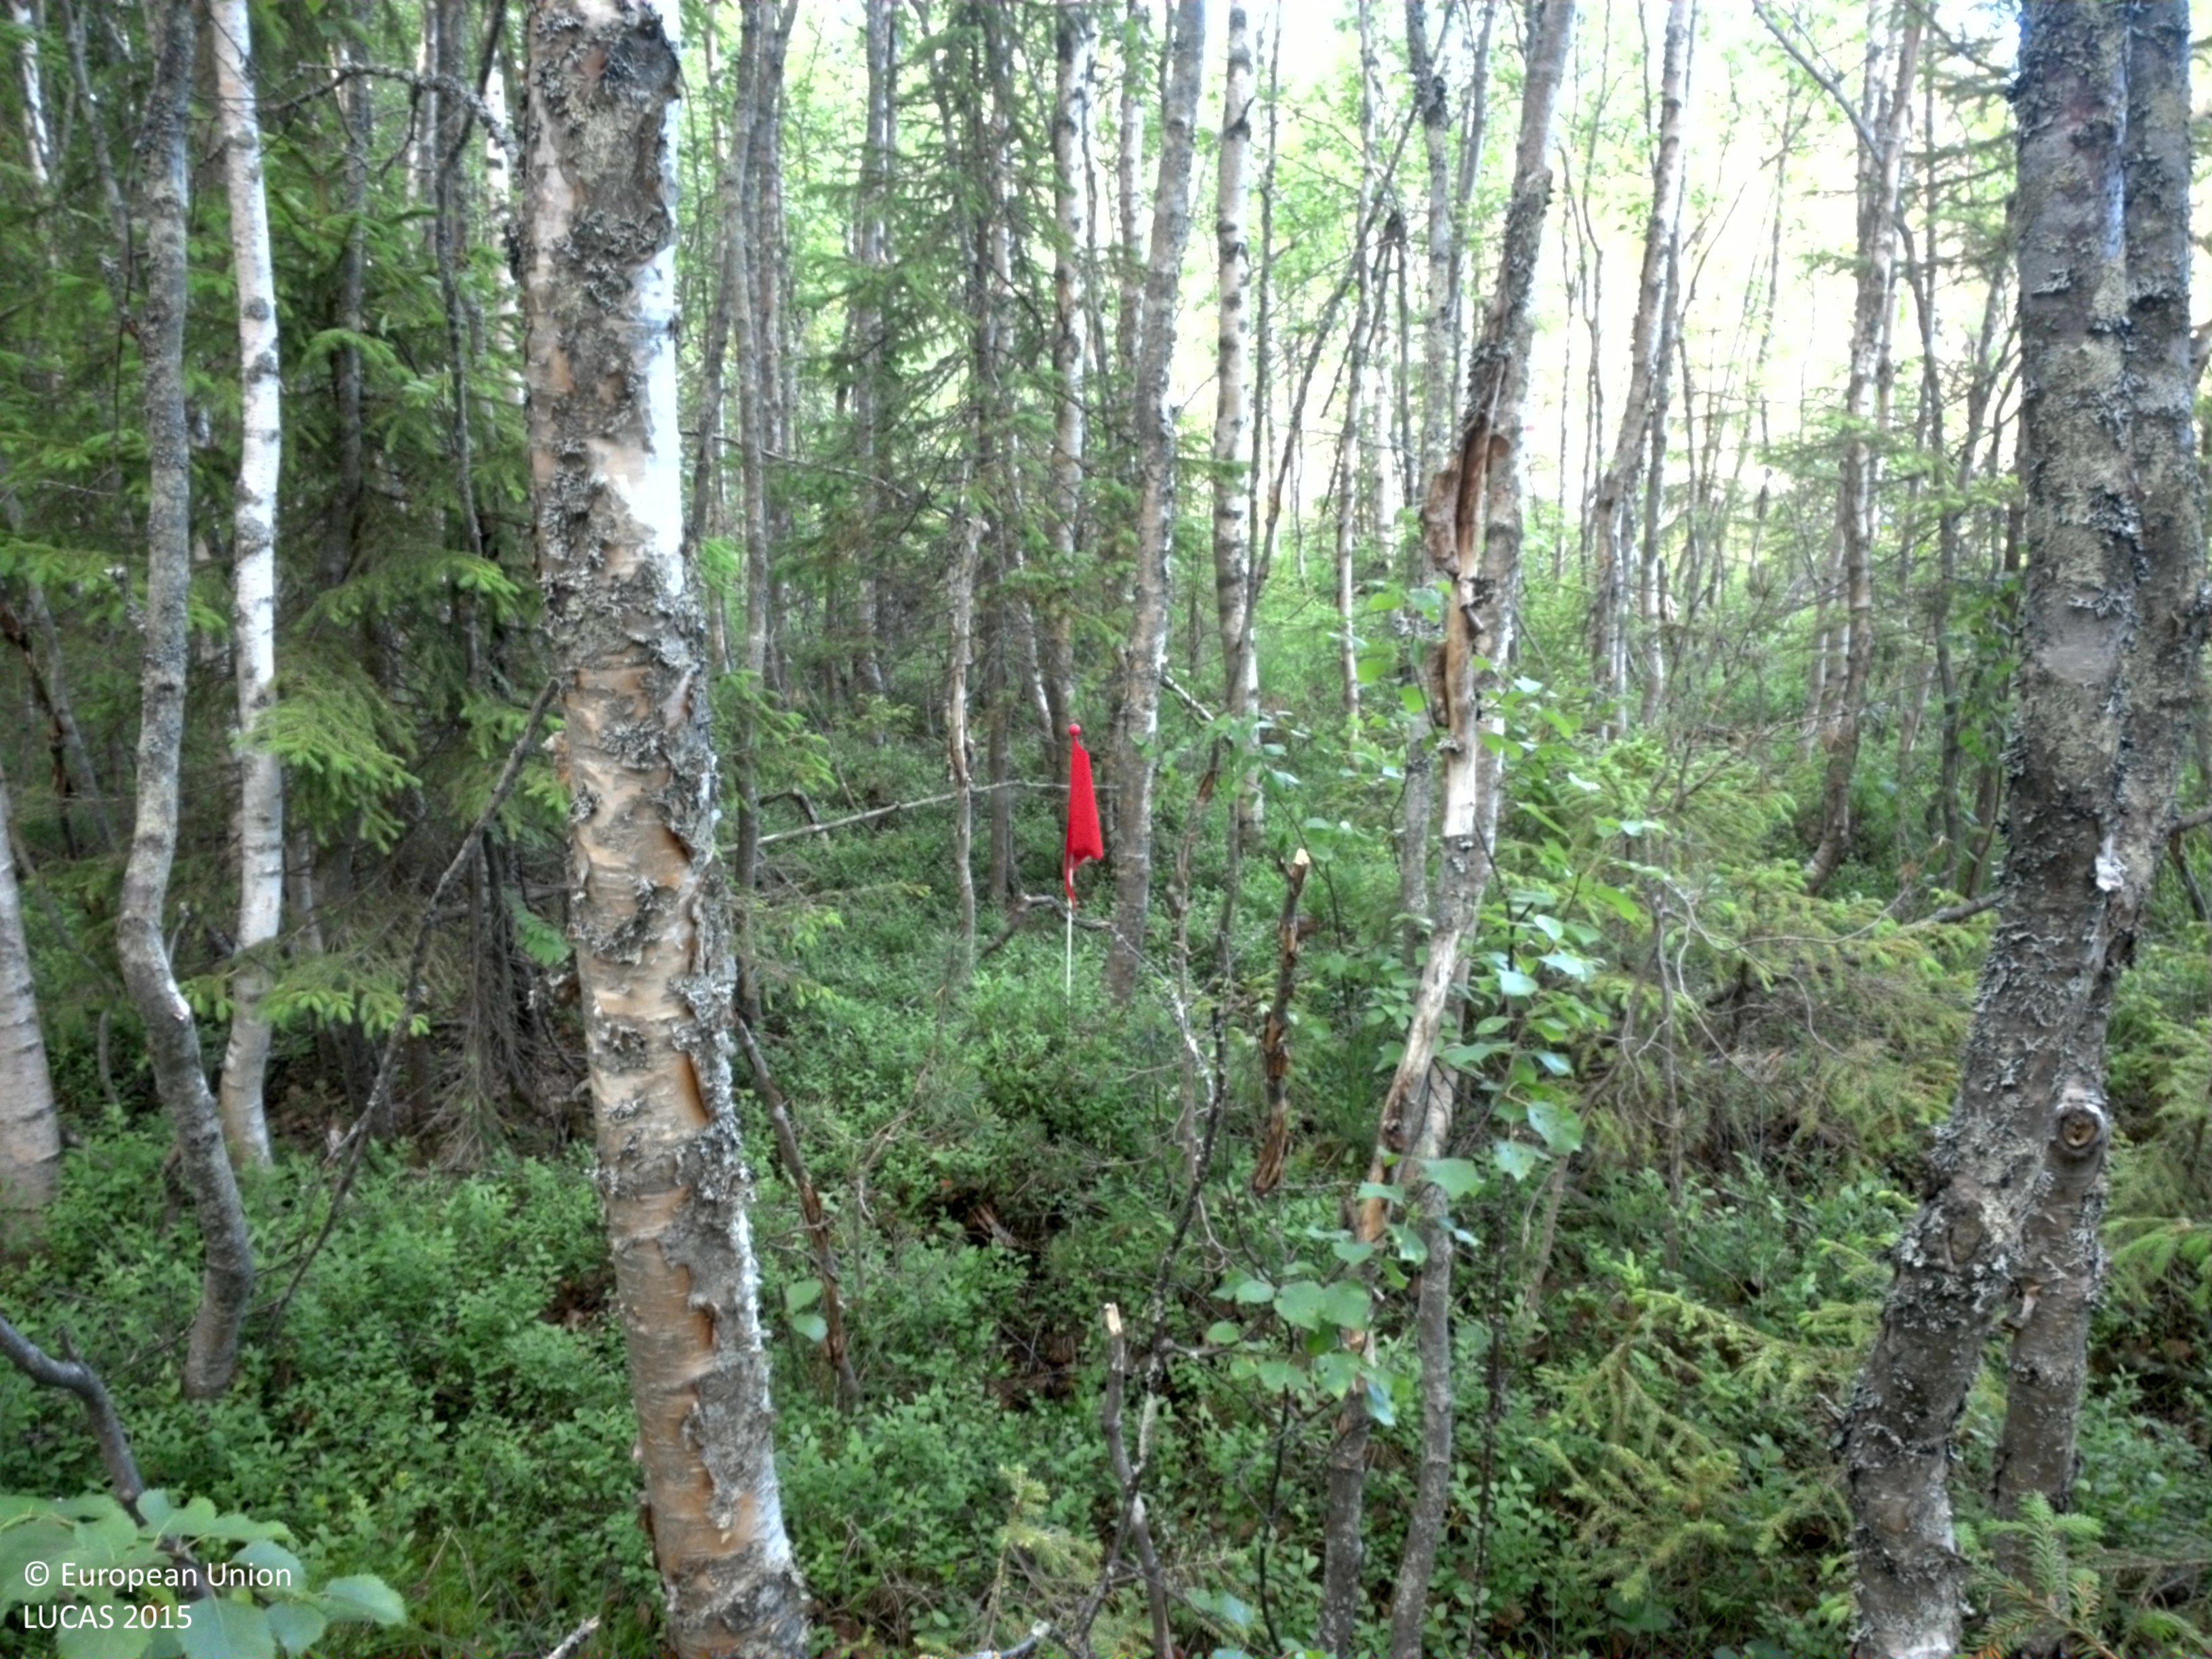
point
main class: Woodland
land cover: Spruce dominated mixed woodland
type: boreal forest
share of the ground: > 75 %
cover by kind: coniferous forest trees 50 %, broadleaved forest trees 35 %, shrubs 15 %
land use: Forestry
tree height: > 5 m
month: June
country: SE
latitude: 64.2527
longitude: 20.7306
